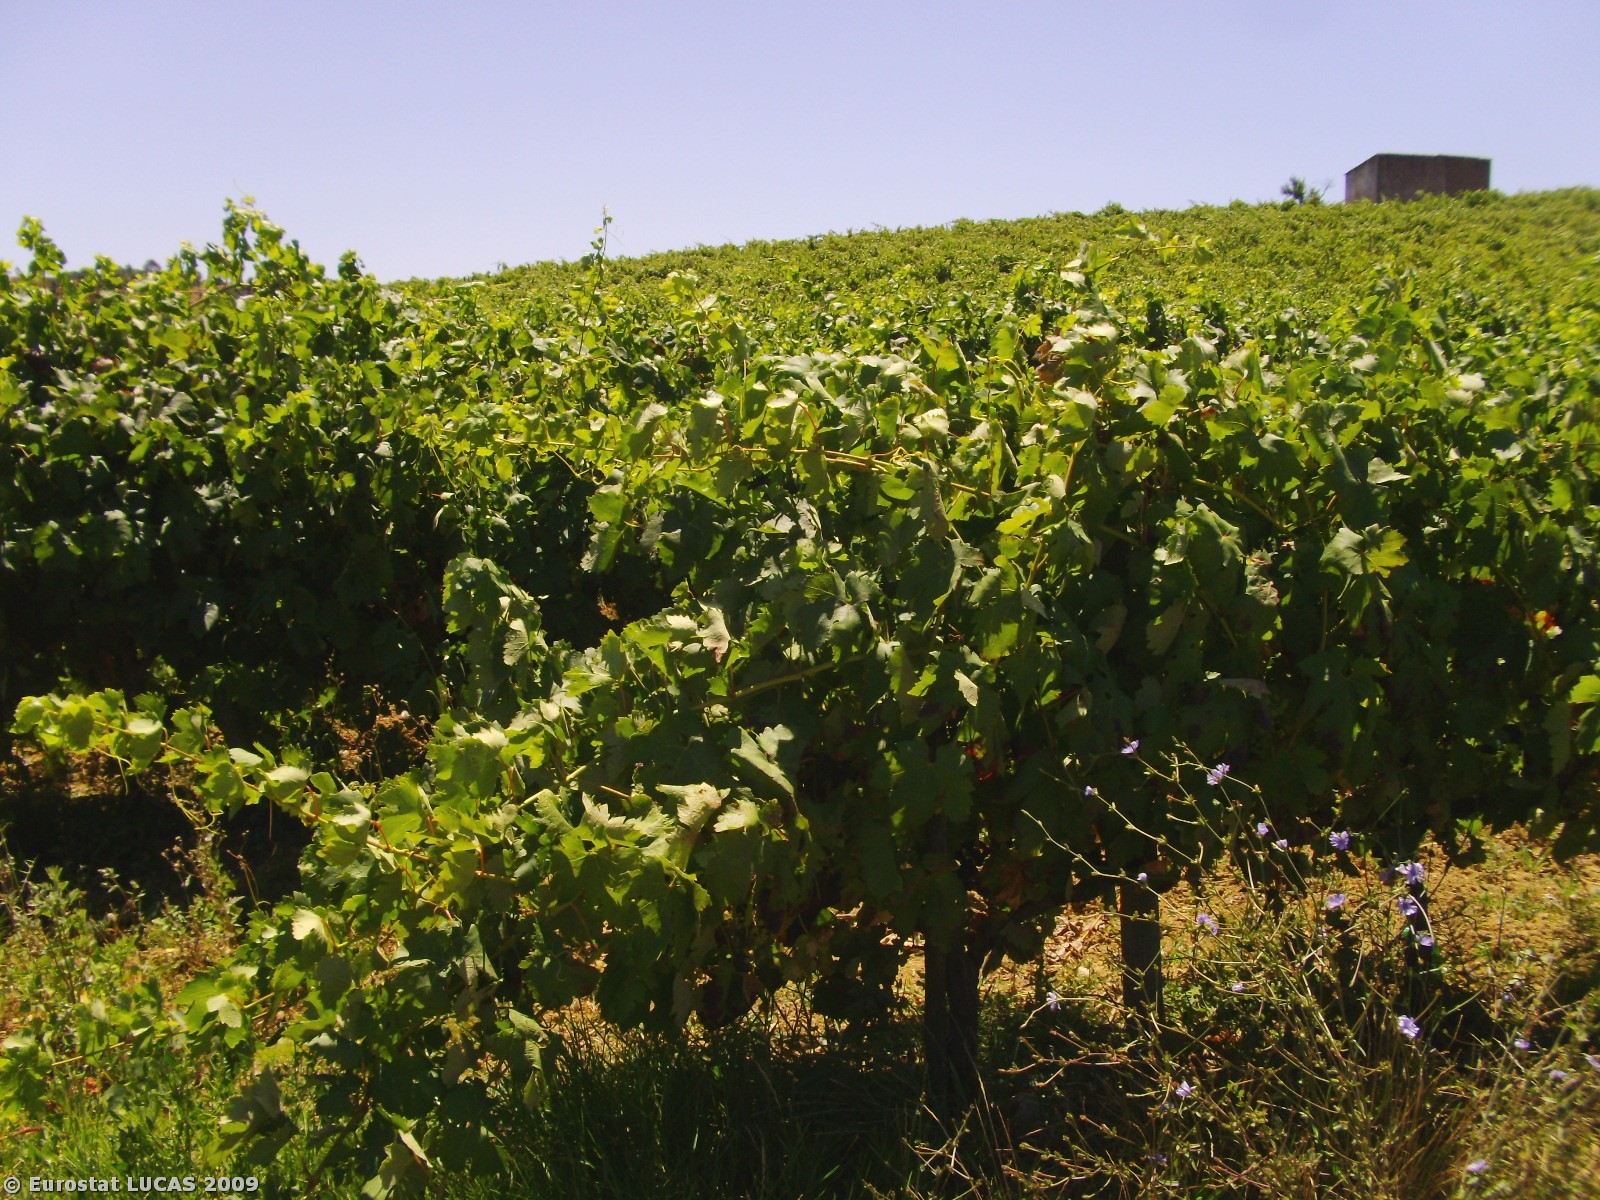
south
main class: Grassland
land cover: Spontaneously vegetated surfaces
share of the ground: 50 - 75 %
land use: Fallow land
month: July
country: PT
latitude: 39.1375
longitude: -9.0664
